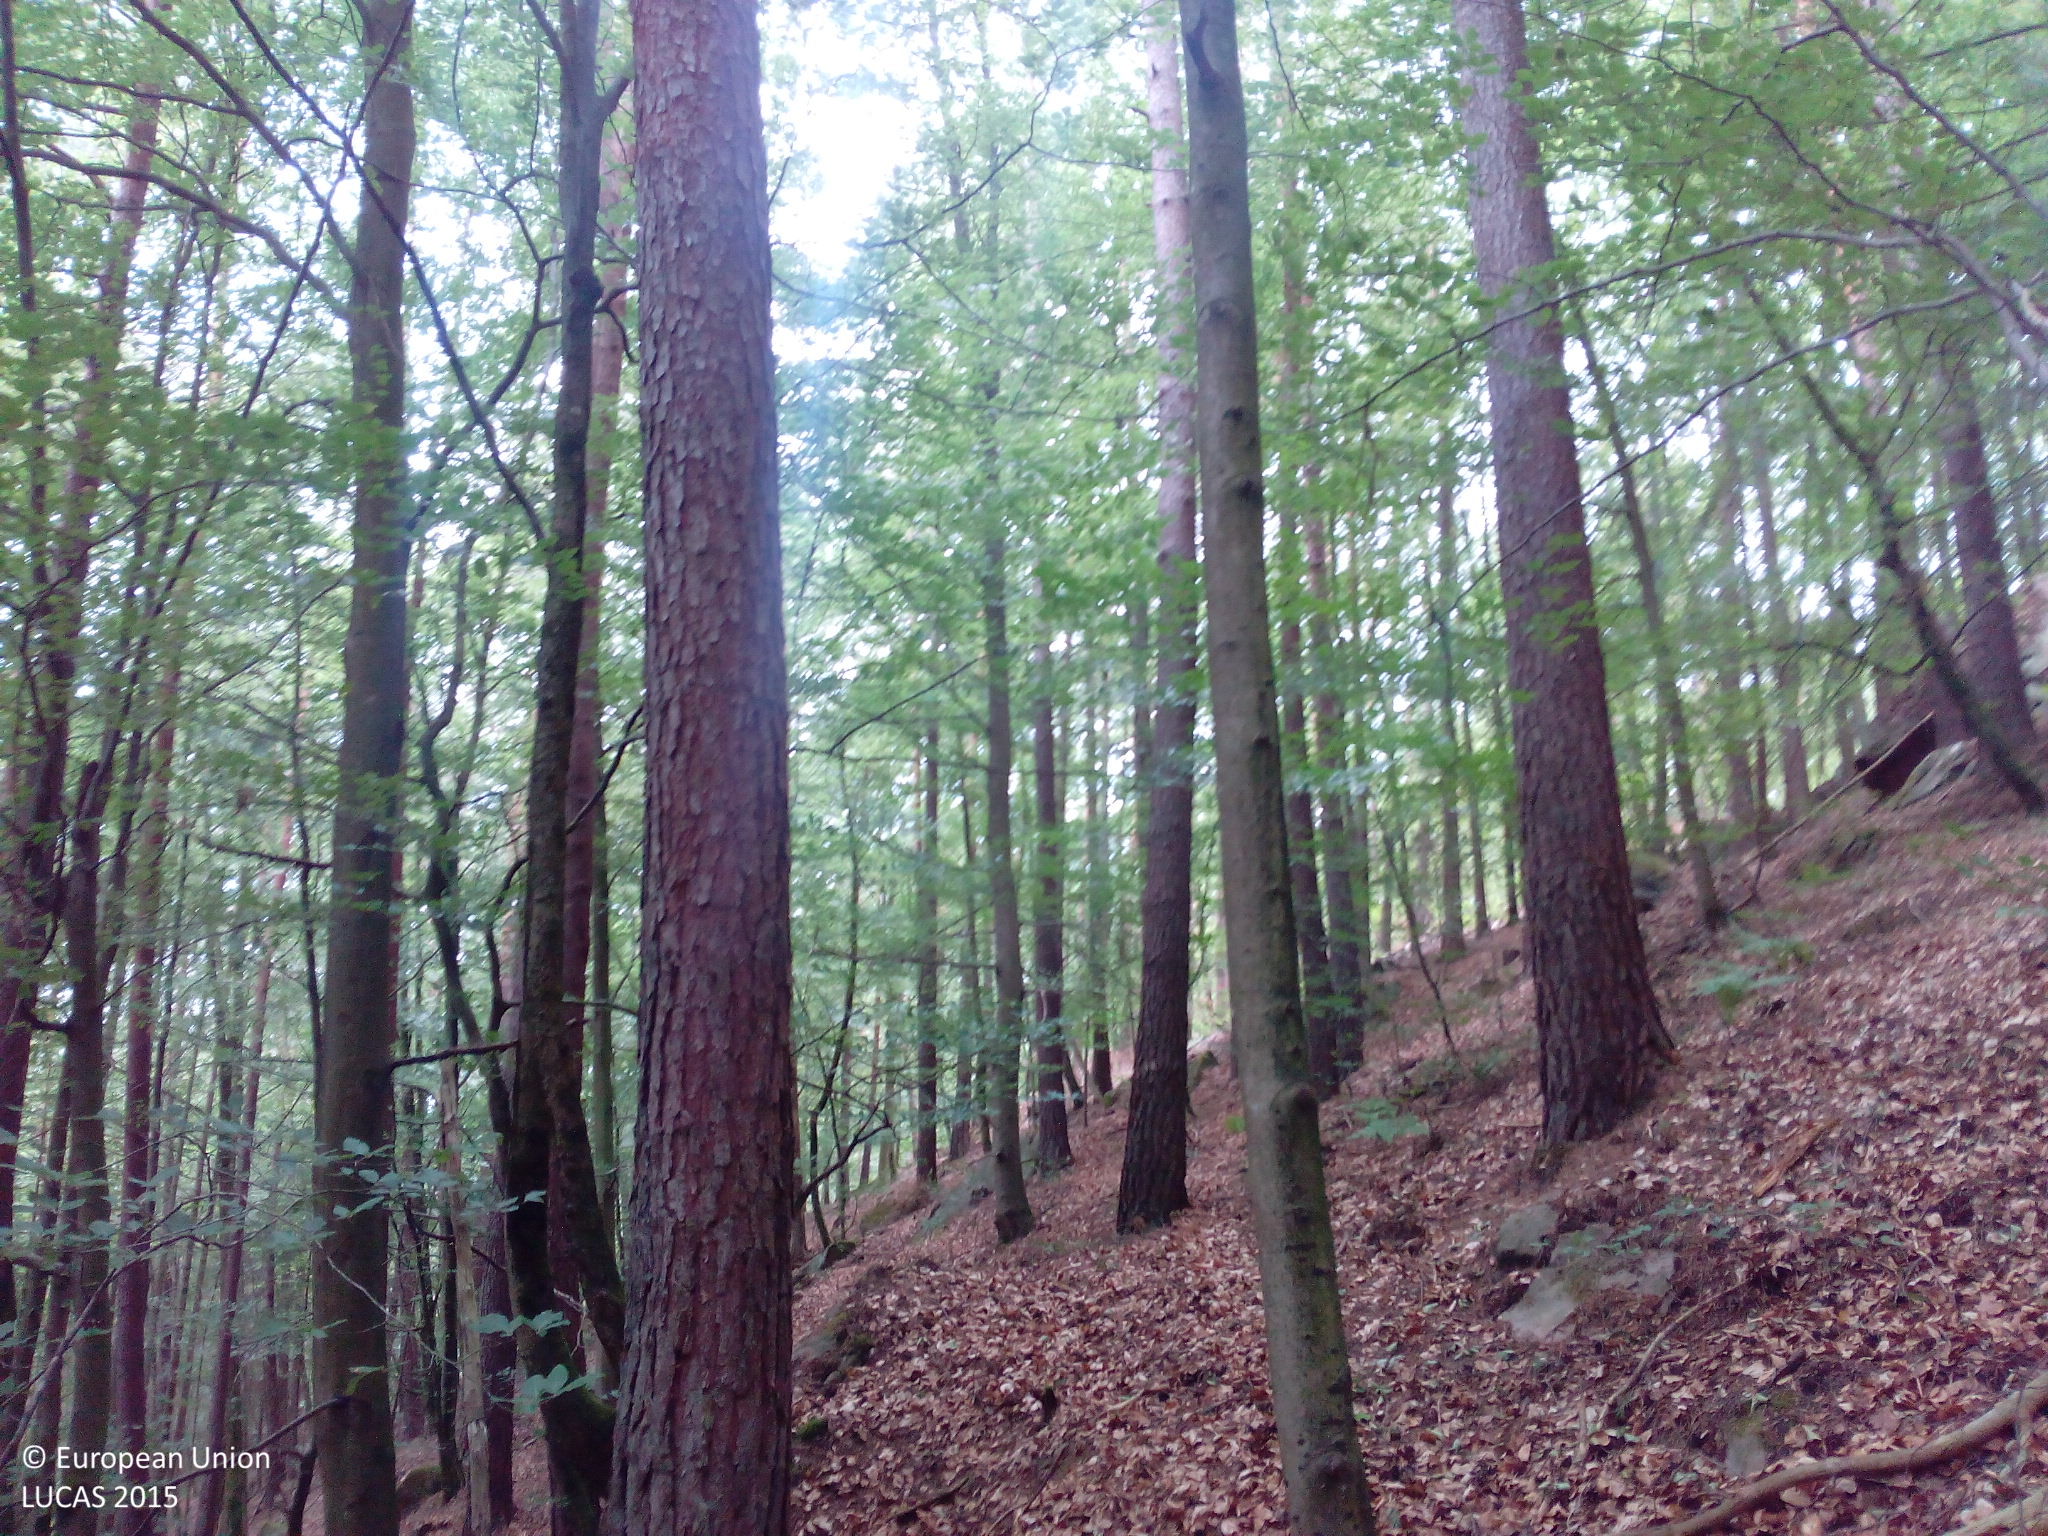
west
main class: Woodland
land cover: Pine dominated mixed woodland
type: hemiboreal forest and nemoral coniferous forest and mixed broadleaved-coniferous forest
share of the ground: > 75 %
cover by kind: broadleaved forest trees 70 %, coniferous forest trees 25 %, unconsolidated bare surface 5 %
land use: Forestry
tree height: > 5 m
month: July
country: DE
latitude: 49.0969
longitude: 7.5765
